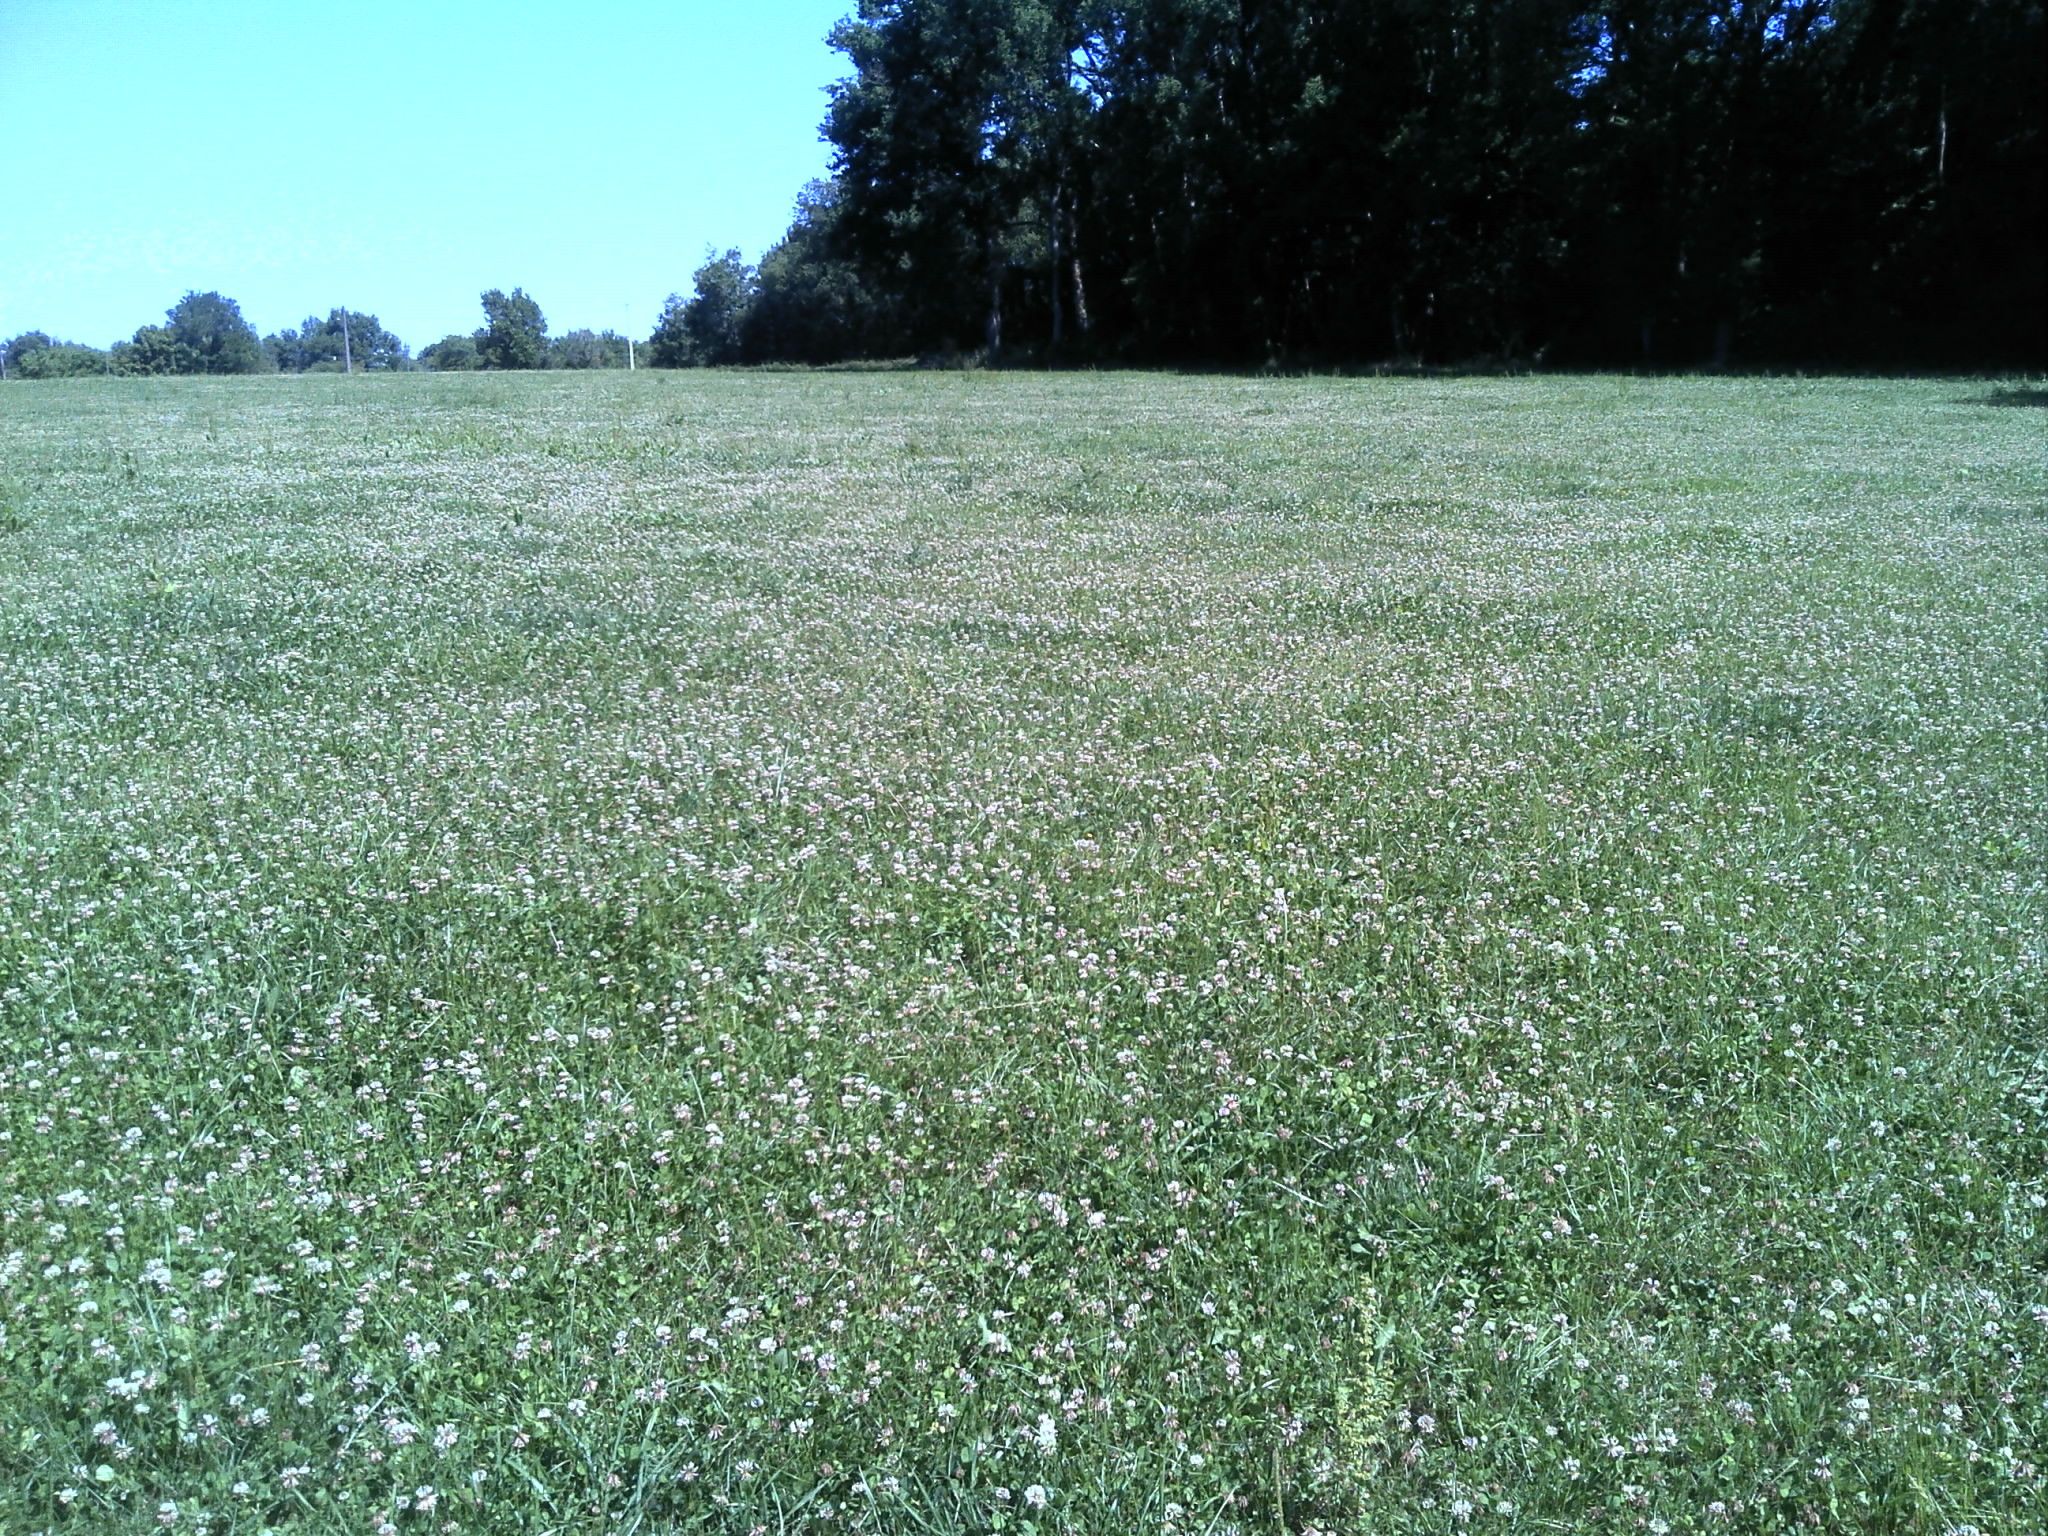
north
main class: Cropland
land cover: Clovers
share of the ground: > 75 %
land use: Agriculture (excluding fallow land and kitchen gardens)
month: June
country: FR
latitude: 46.6532
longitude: 1.1404
